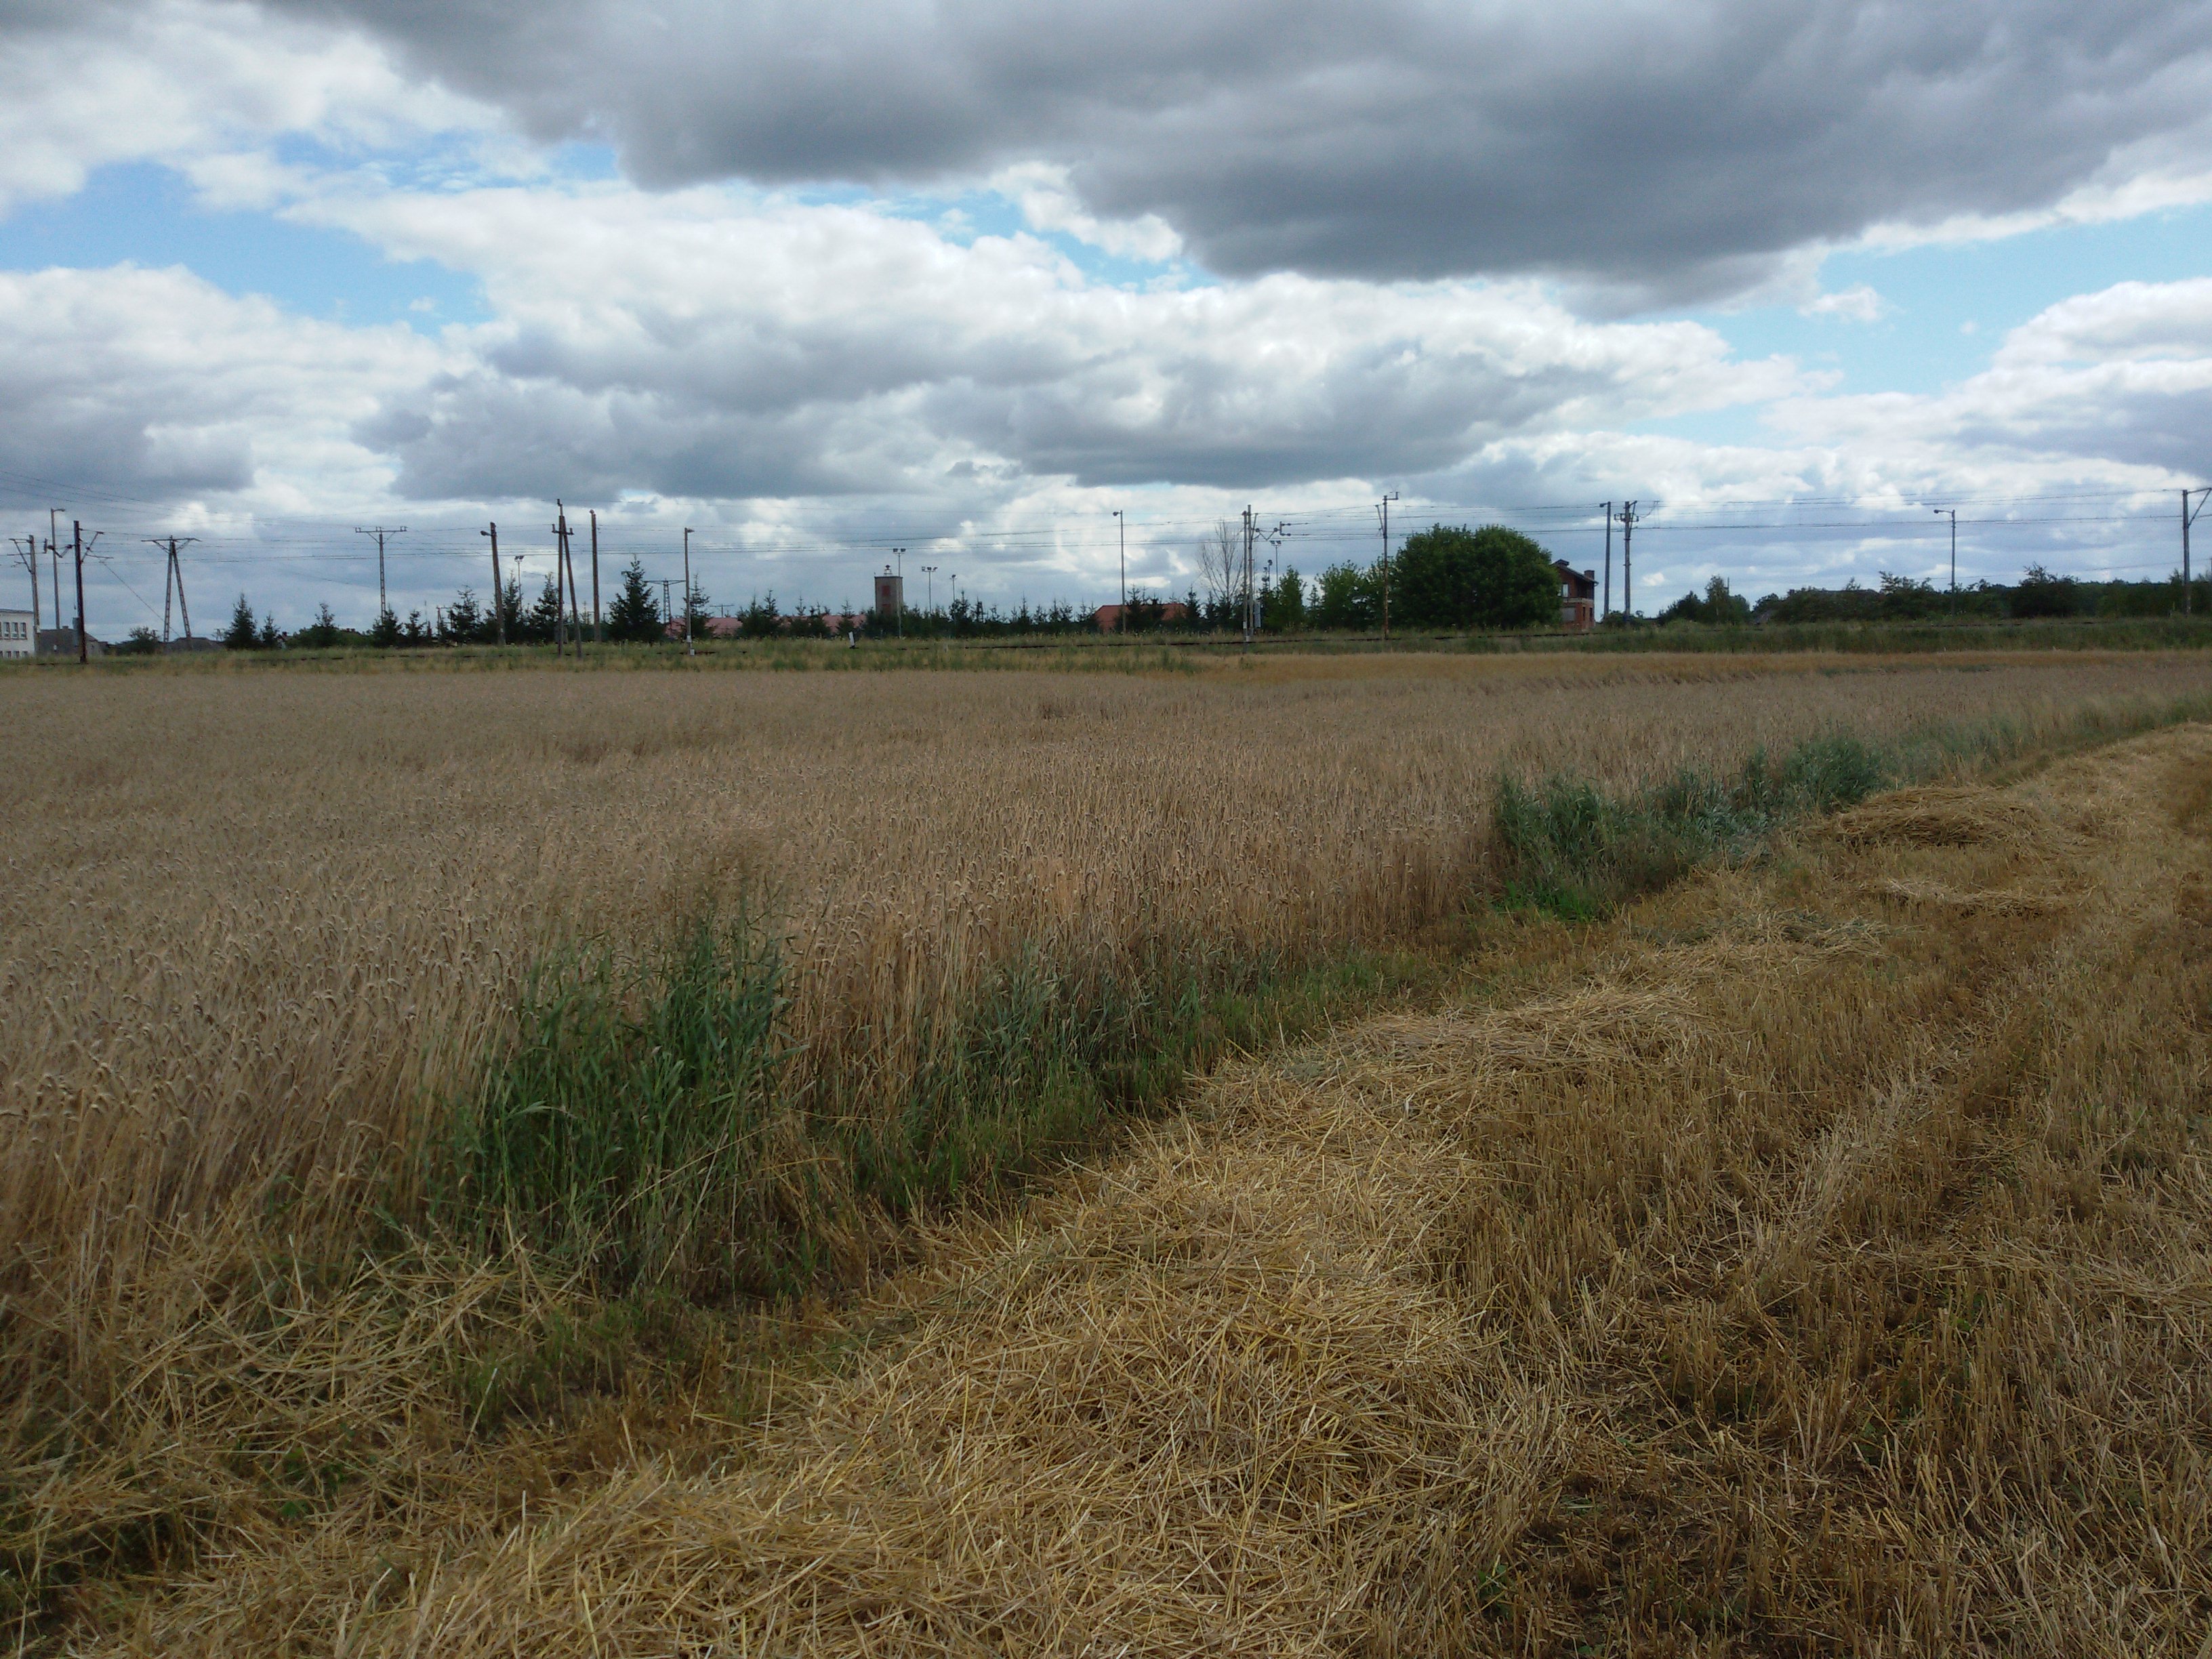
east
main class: Cropland
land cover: Common wheat
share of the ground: > 75 %
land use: Agriculture (excluding fallow land and kitchen gardens)
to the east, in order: Common wheat; Rye; Oats; Rye; Electric lines; Rye; Grass margins; Ditches and canals; Spontaneously vegetated surfaces; Electric lines; Railways; Electric lines; Spontaneously vegetated surfaces; Grassland with sparse tree/shrub cover; Railways; Electric lines; Grassland with sparse tree/shrub cover; Railways; Artificial constructions in urban areas
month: July
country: PL
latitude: 52.1236
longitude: 17.4762
